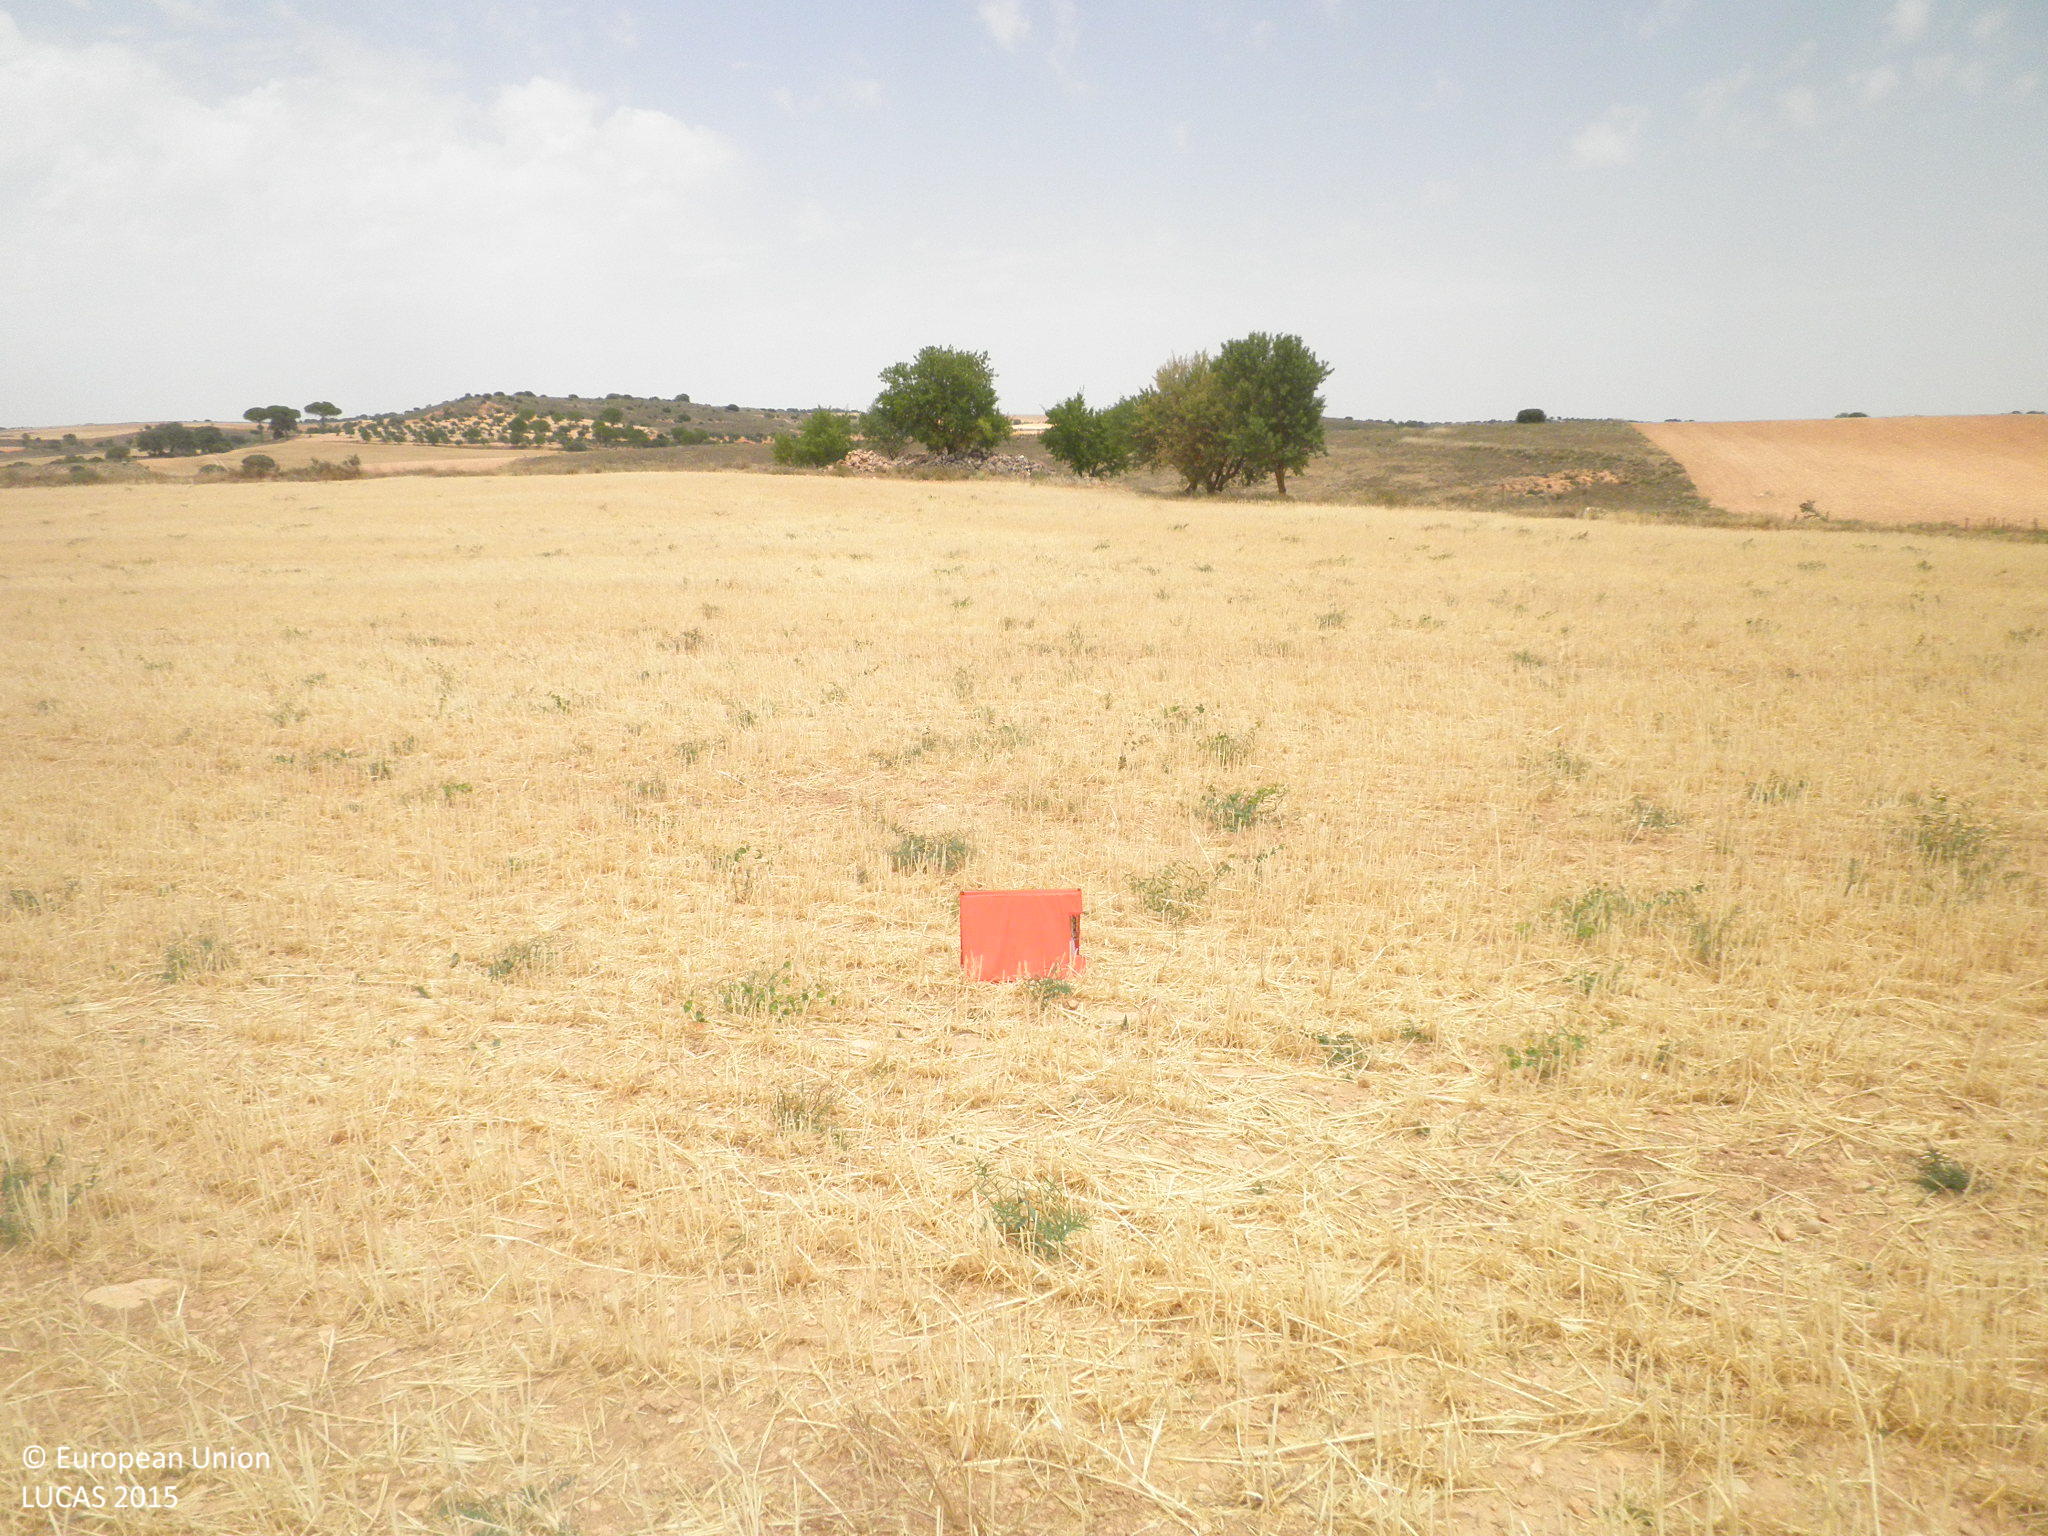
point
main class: Cropland
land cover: Barley
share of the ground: 25 - 50 %
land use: Agriculture (excluding fallow land and kitchen gardens)
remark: Harvested field
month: July
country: ES
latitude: 39.5319
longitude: -2.6840
